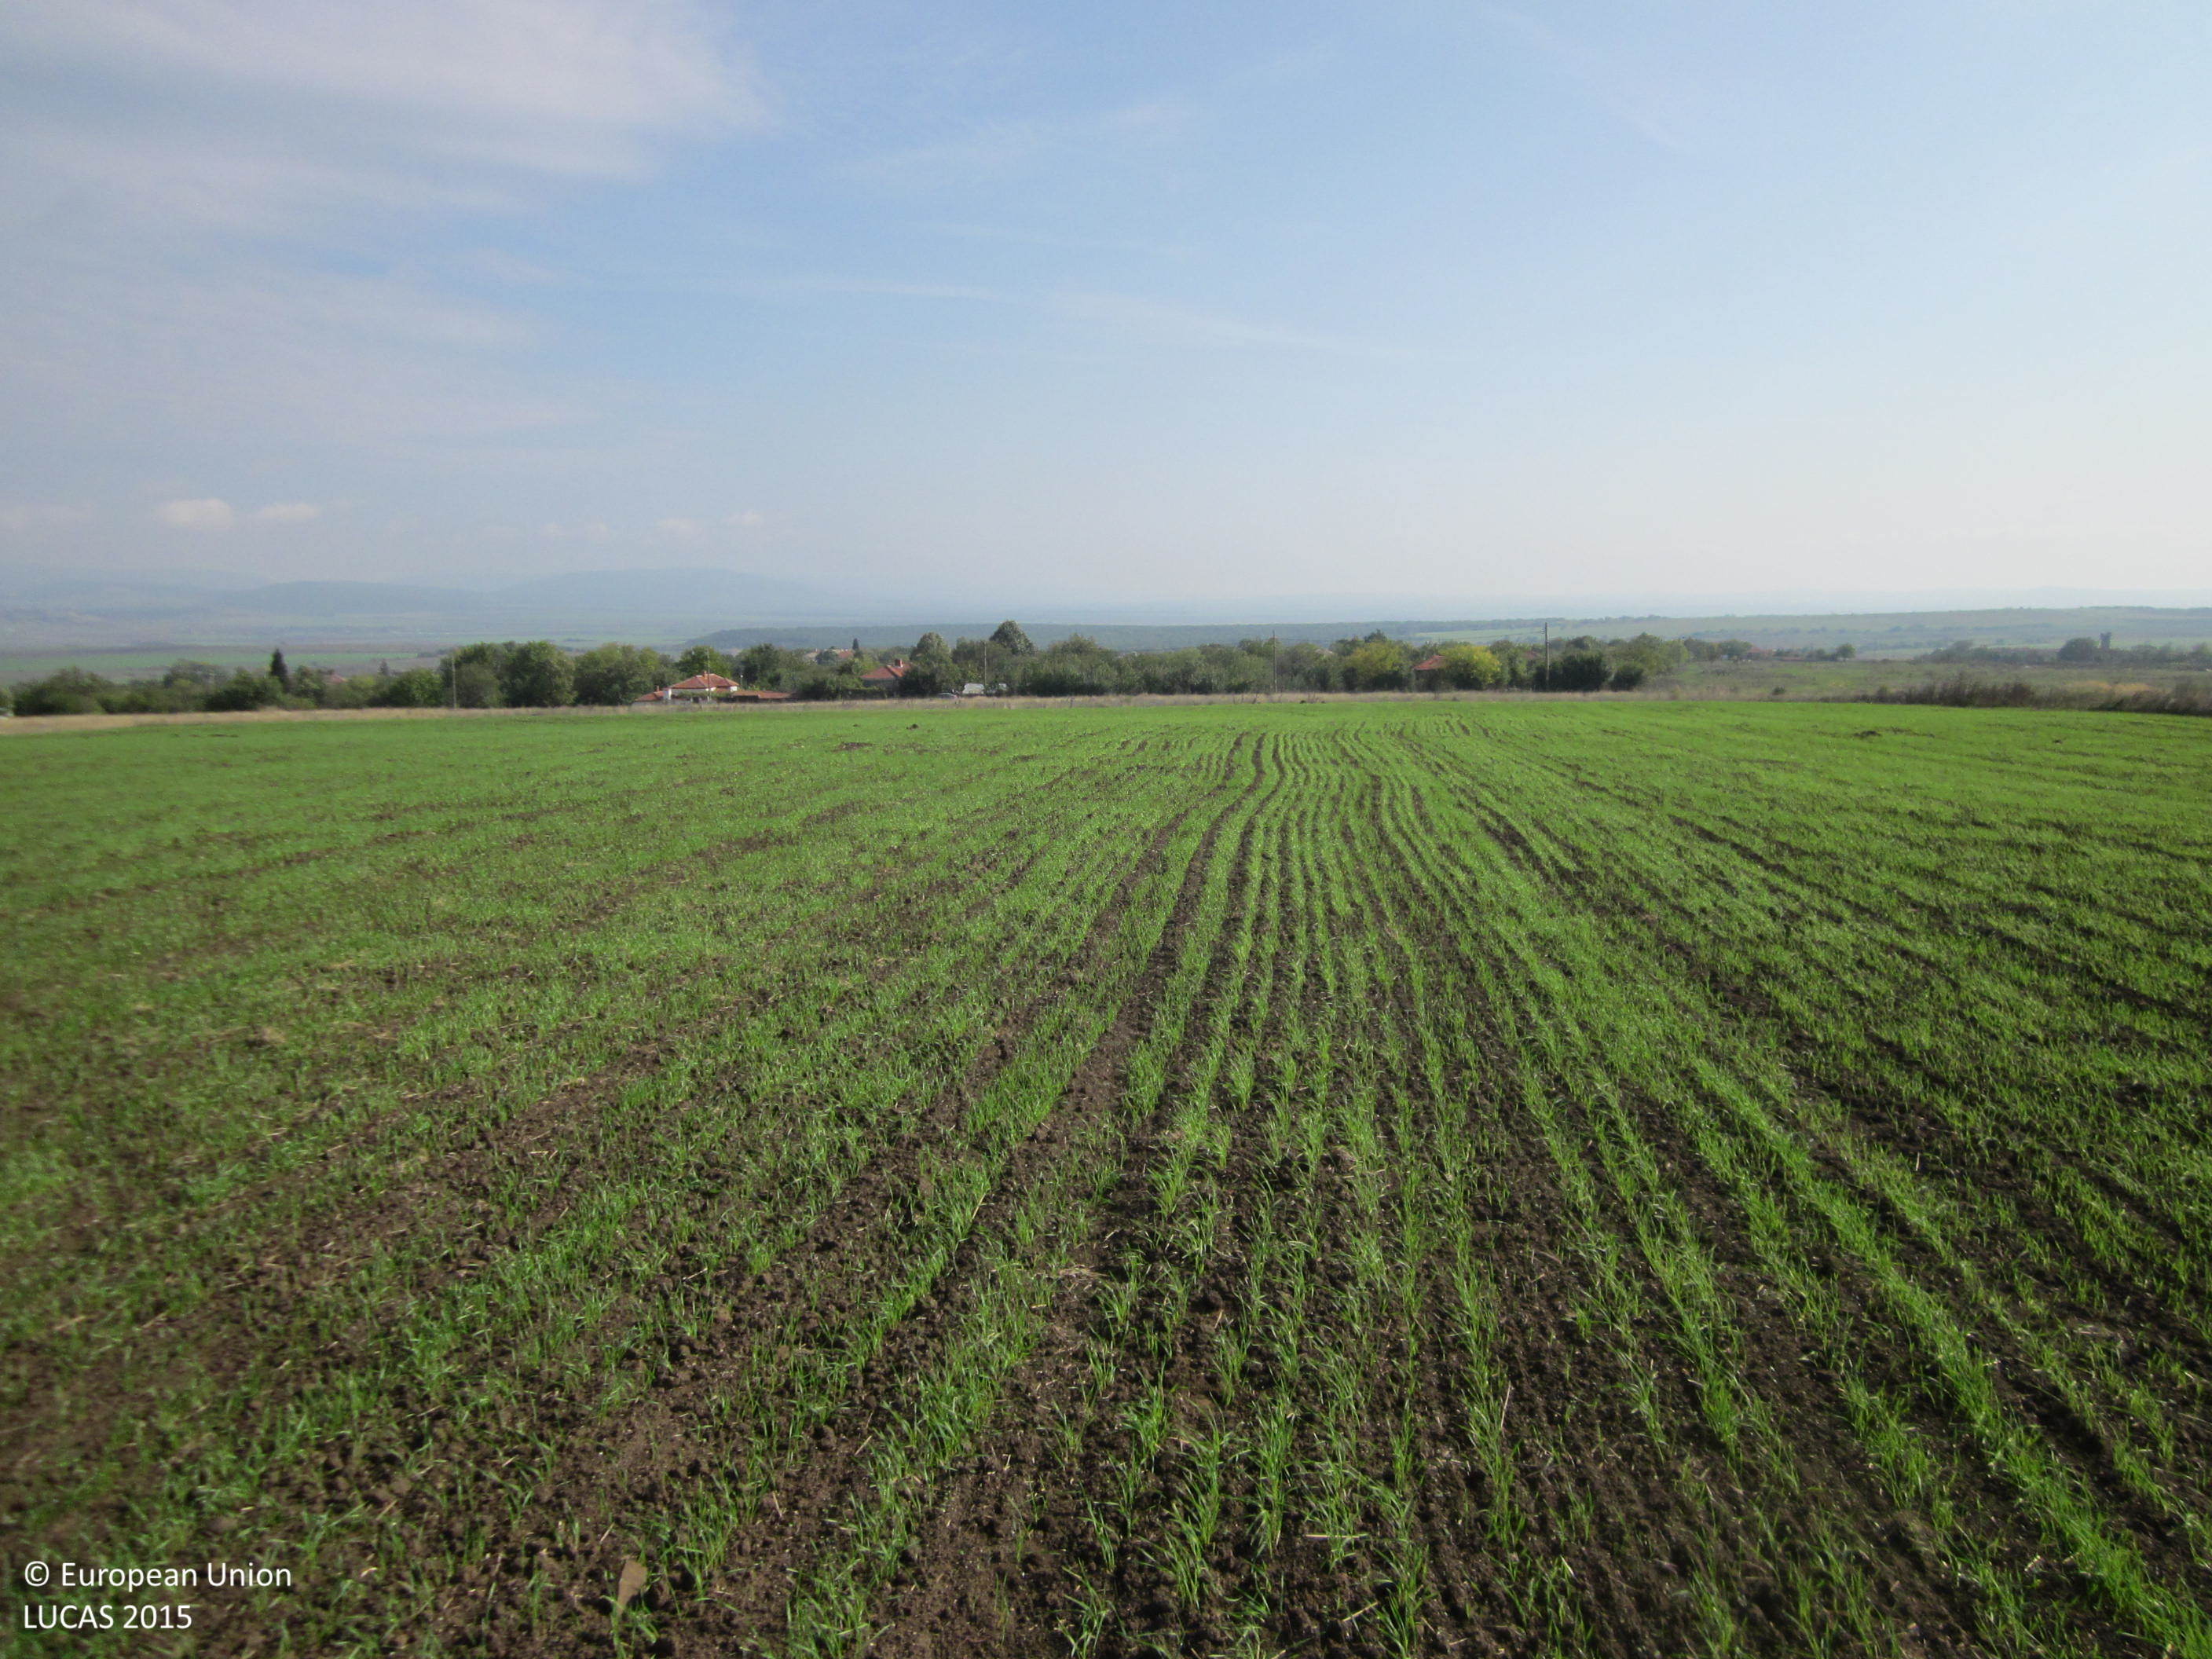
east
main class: Cropland
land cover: Common wheat
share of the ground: 25 - 50 %
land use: Agriculture (excluding fallow land and kitchen gardens)
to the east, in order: Common wheat; Grassland without tree/shrub cover; Tracks; Grassland without tree/shrub cover; Electric lines; Tracks; Grass margins; Artificial constructions in urban areas
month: October
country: BG
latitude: 42.6909
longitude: 26.8120
